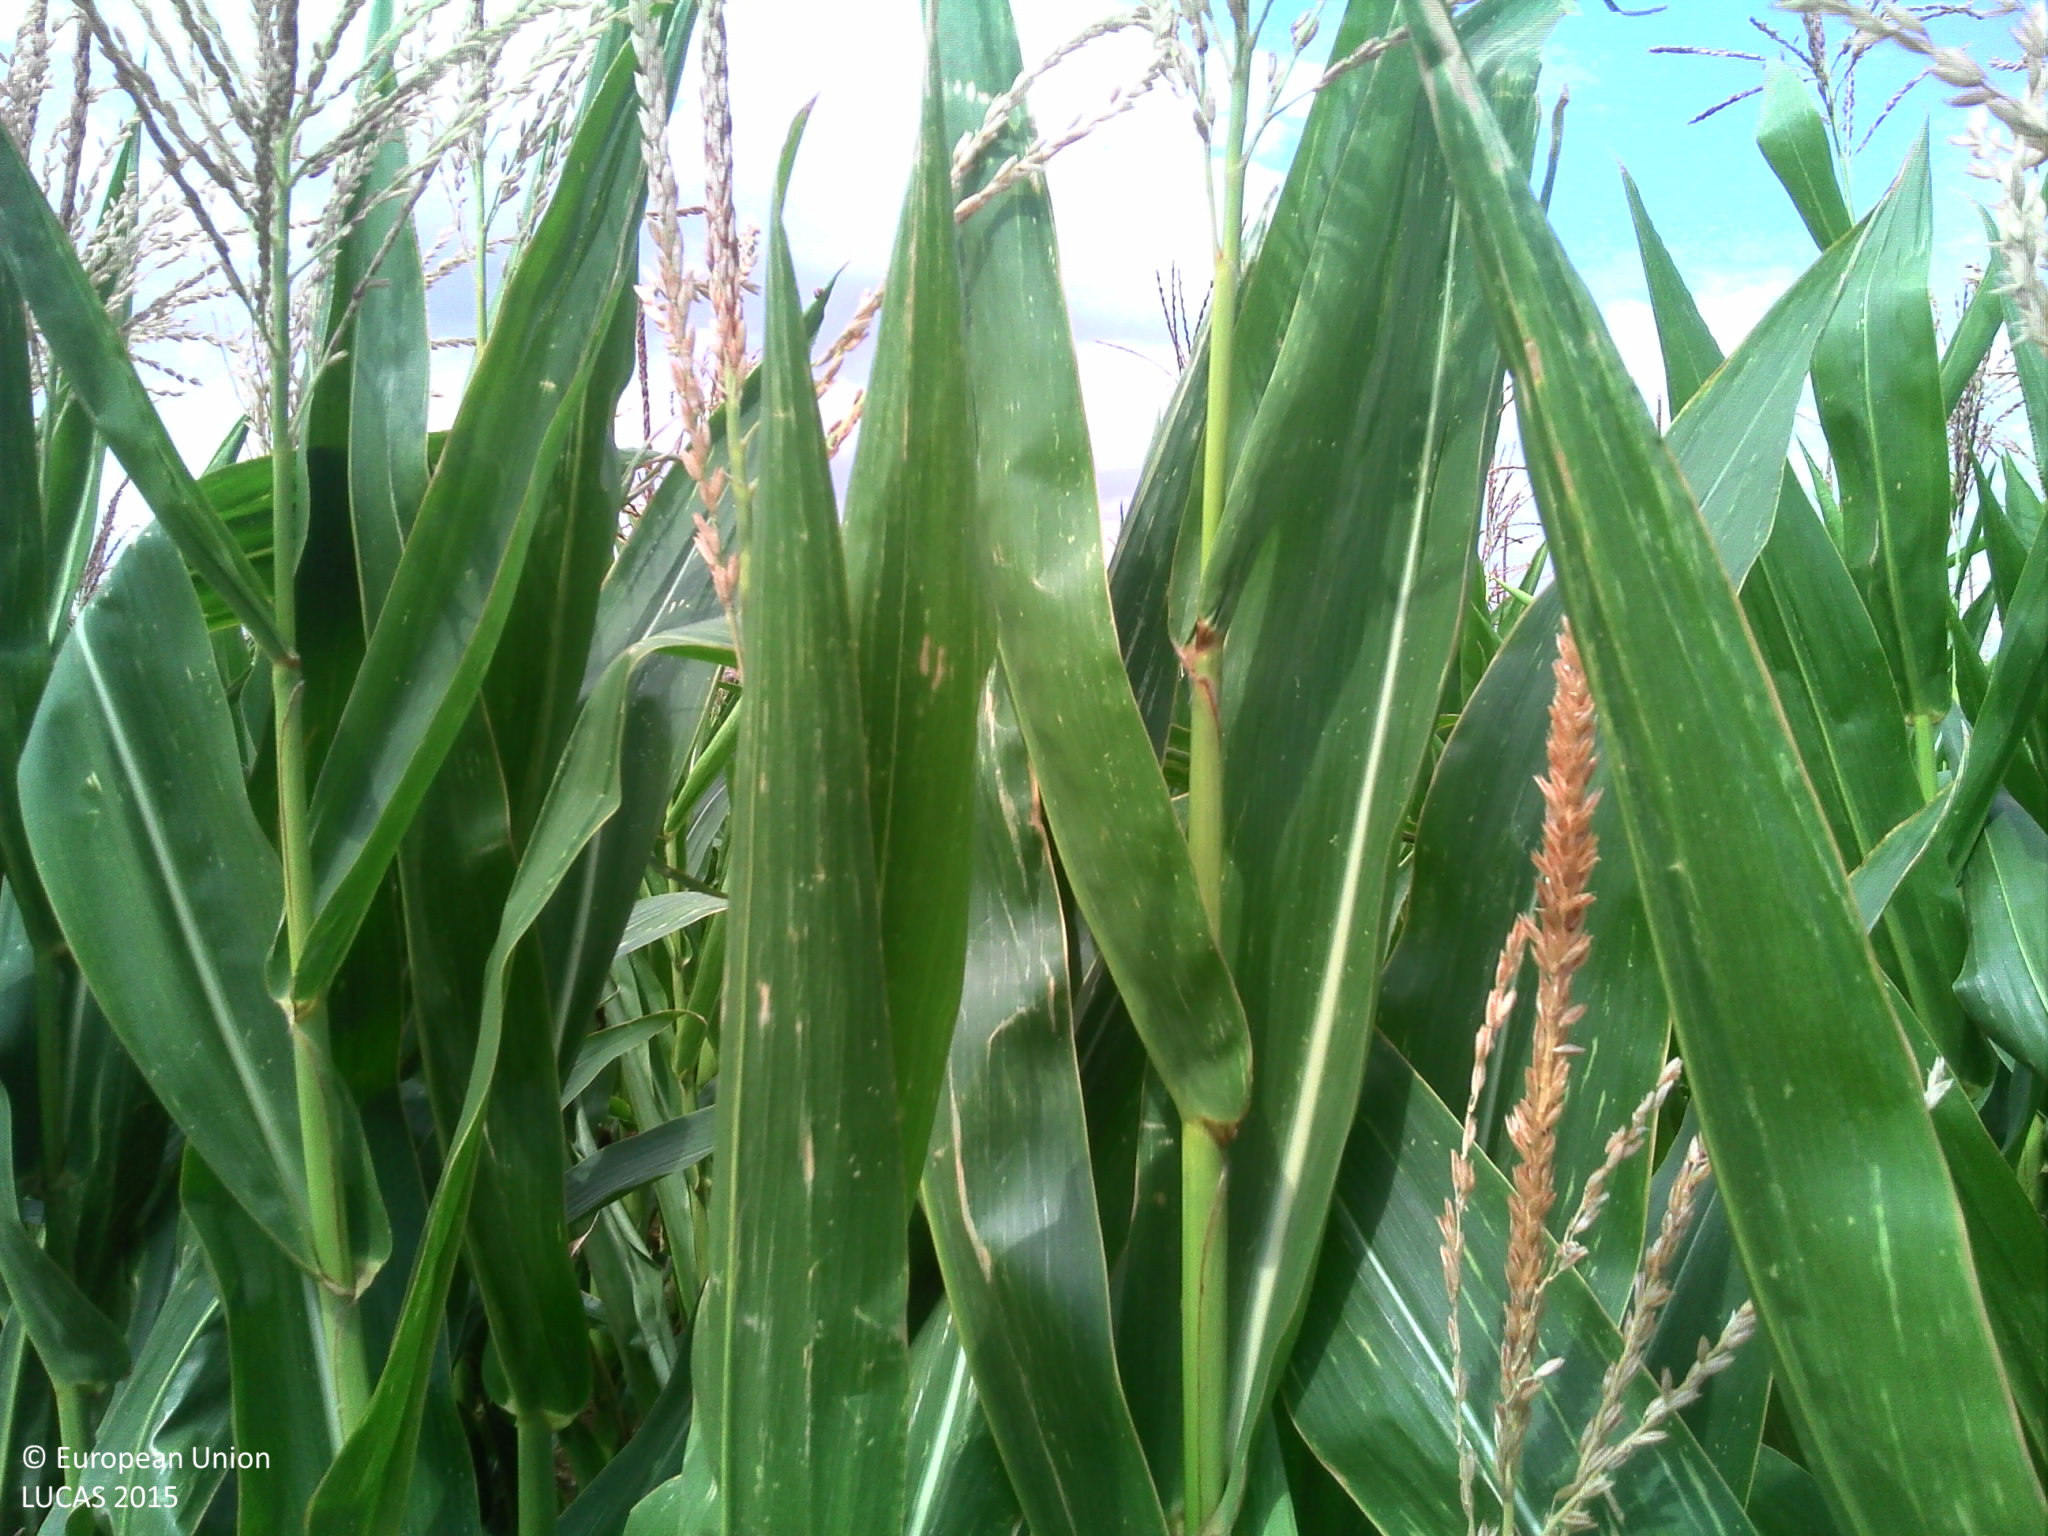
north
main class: Cropland
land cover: Maize
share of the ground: > 75 %
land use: Agriculture (excluding fallow land and kitchen gardens)
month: August
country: FR
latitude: 49.0343
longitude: 2.5065
